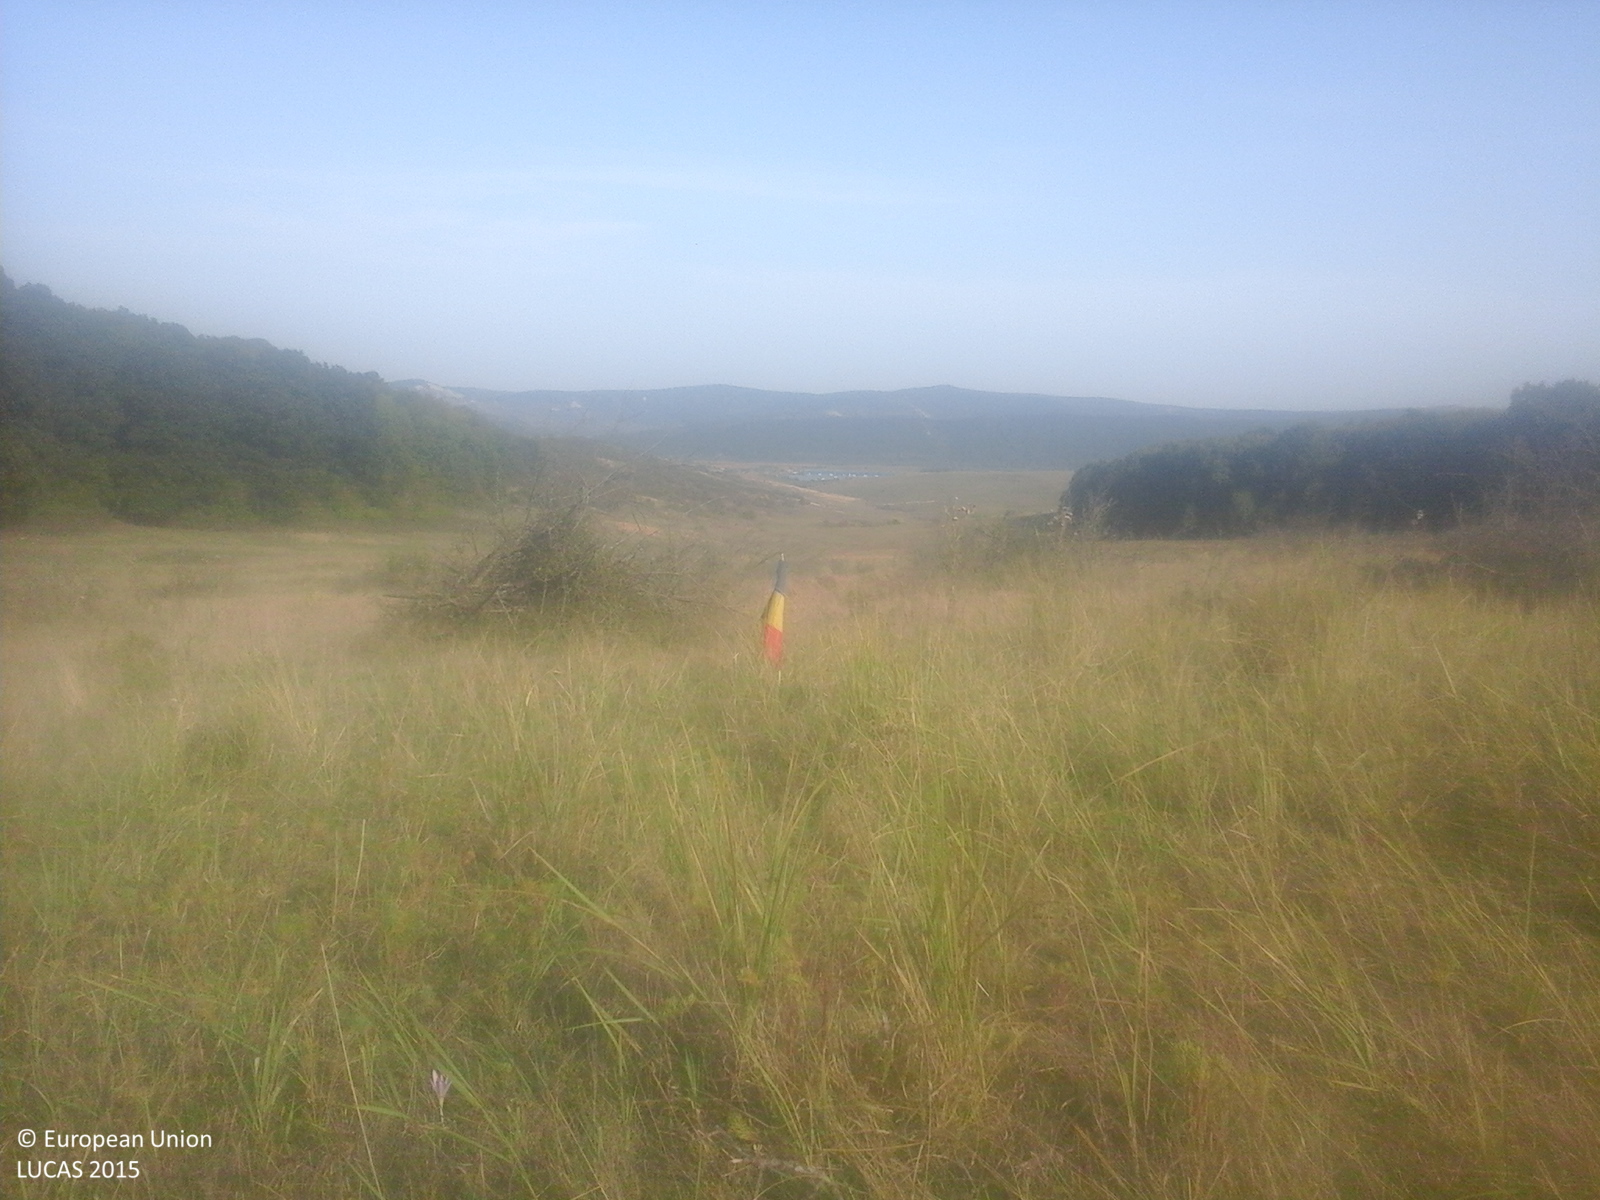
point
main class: Grassland
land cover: Grassland with sparse tree/shrub cover
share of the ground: > 75 %
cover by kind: herbaceous plants 85 %, shrubs 10 %, broadleaved forest trees 5 %
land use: Agriculture (excluding fallow land and kitchen gardens)
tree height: < 5 m
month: September
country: RO
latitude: 46.9724
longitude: 23.7587
